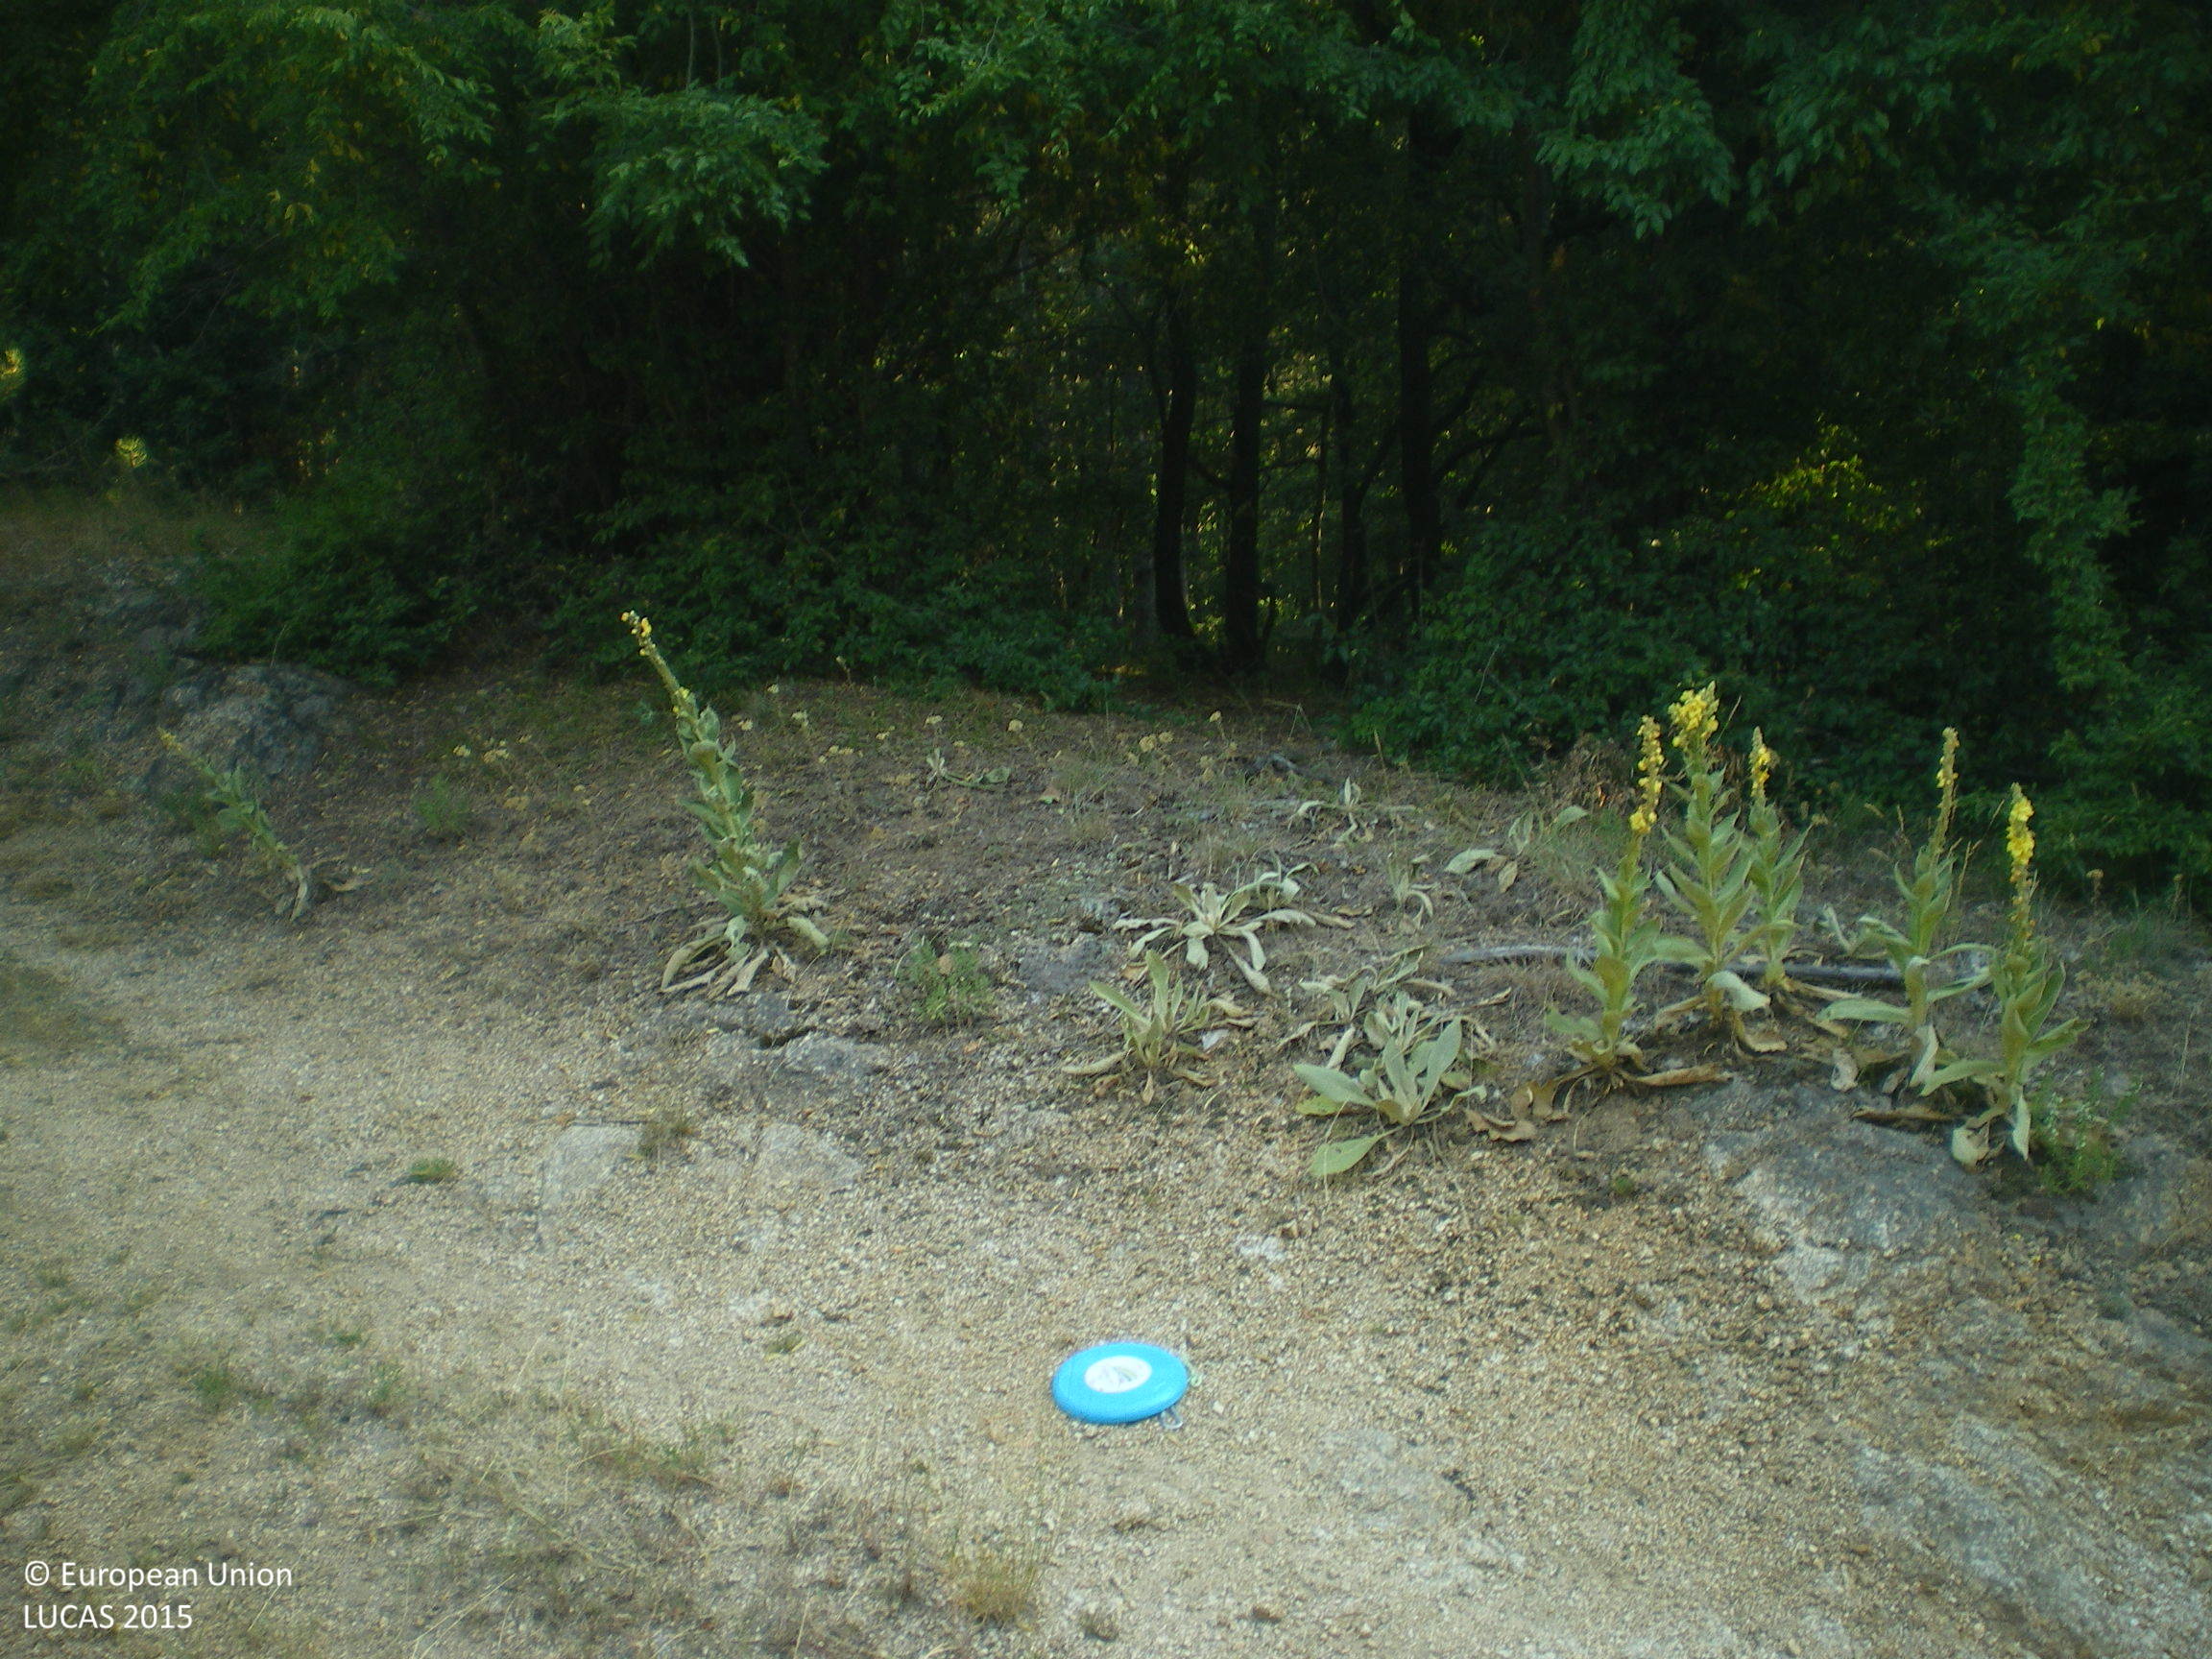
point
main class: Woodland
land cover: Broadleaved woodland
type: mesophytic deciduous forest
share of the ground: > 75 %
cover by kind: broadleaved forest trees 65 %, herbaceous plants 20 %, shrubs 15 %
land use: Forestry
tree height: > 5 m
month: July
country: BG
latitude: 42.6404
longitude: 25.0515
